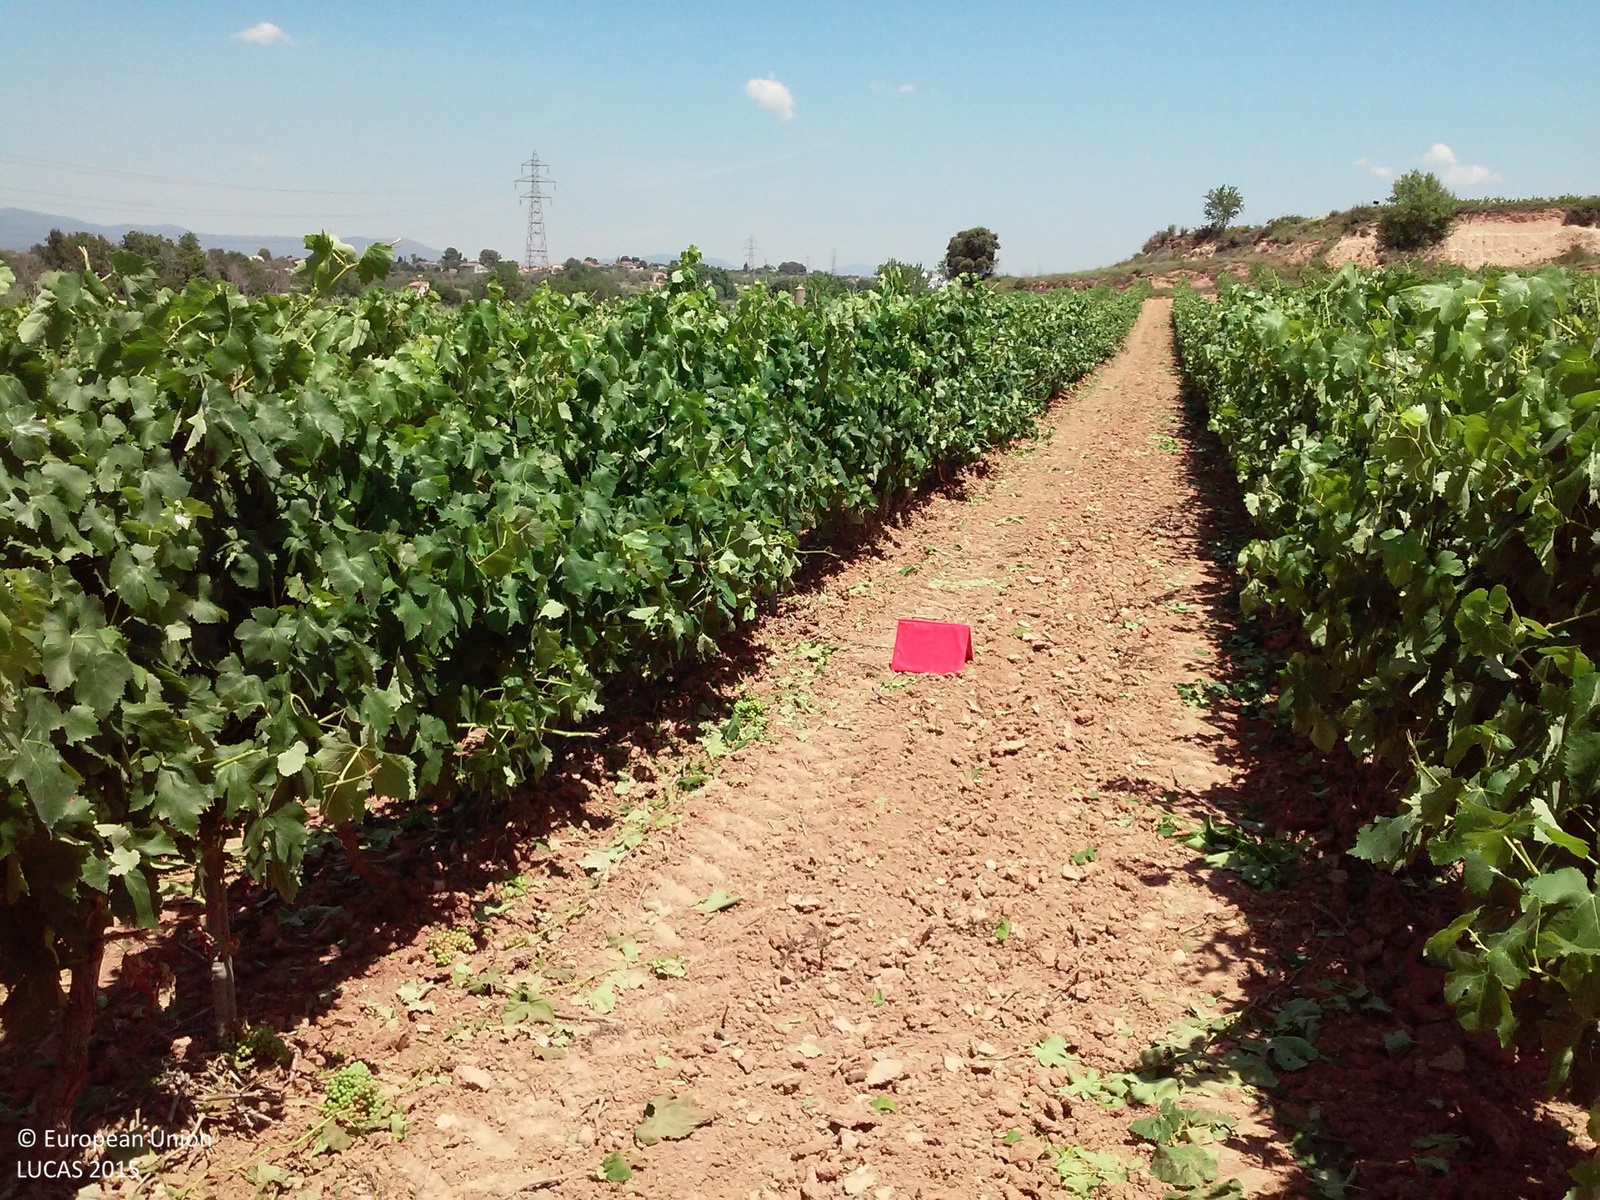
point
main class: Cropland
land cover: Vineyards
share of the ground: 25 - 50 %
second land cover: Other bare soil
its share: > 75 %
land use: Agriculture (excluding fallow land and kitchen gardens)
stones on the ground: 25 - 50 %
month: June
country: ES
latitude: 41.2592
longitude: 1.2682
